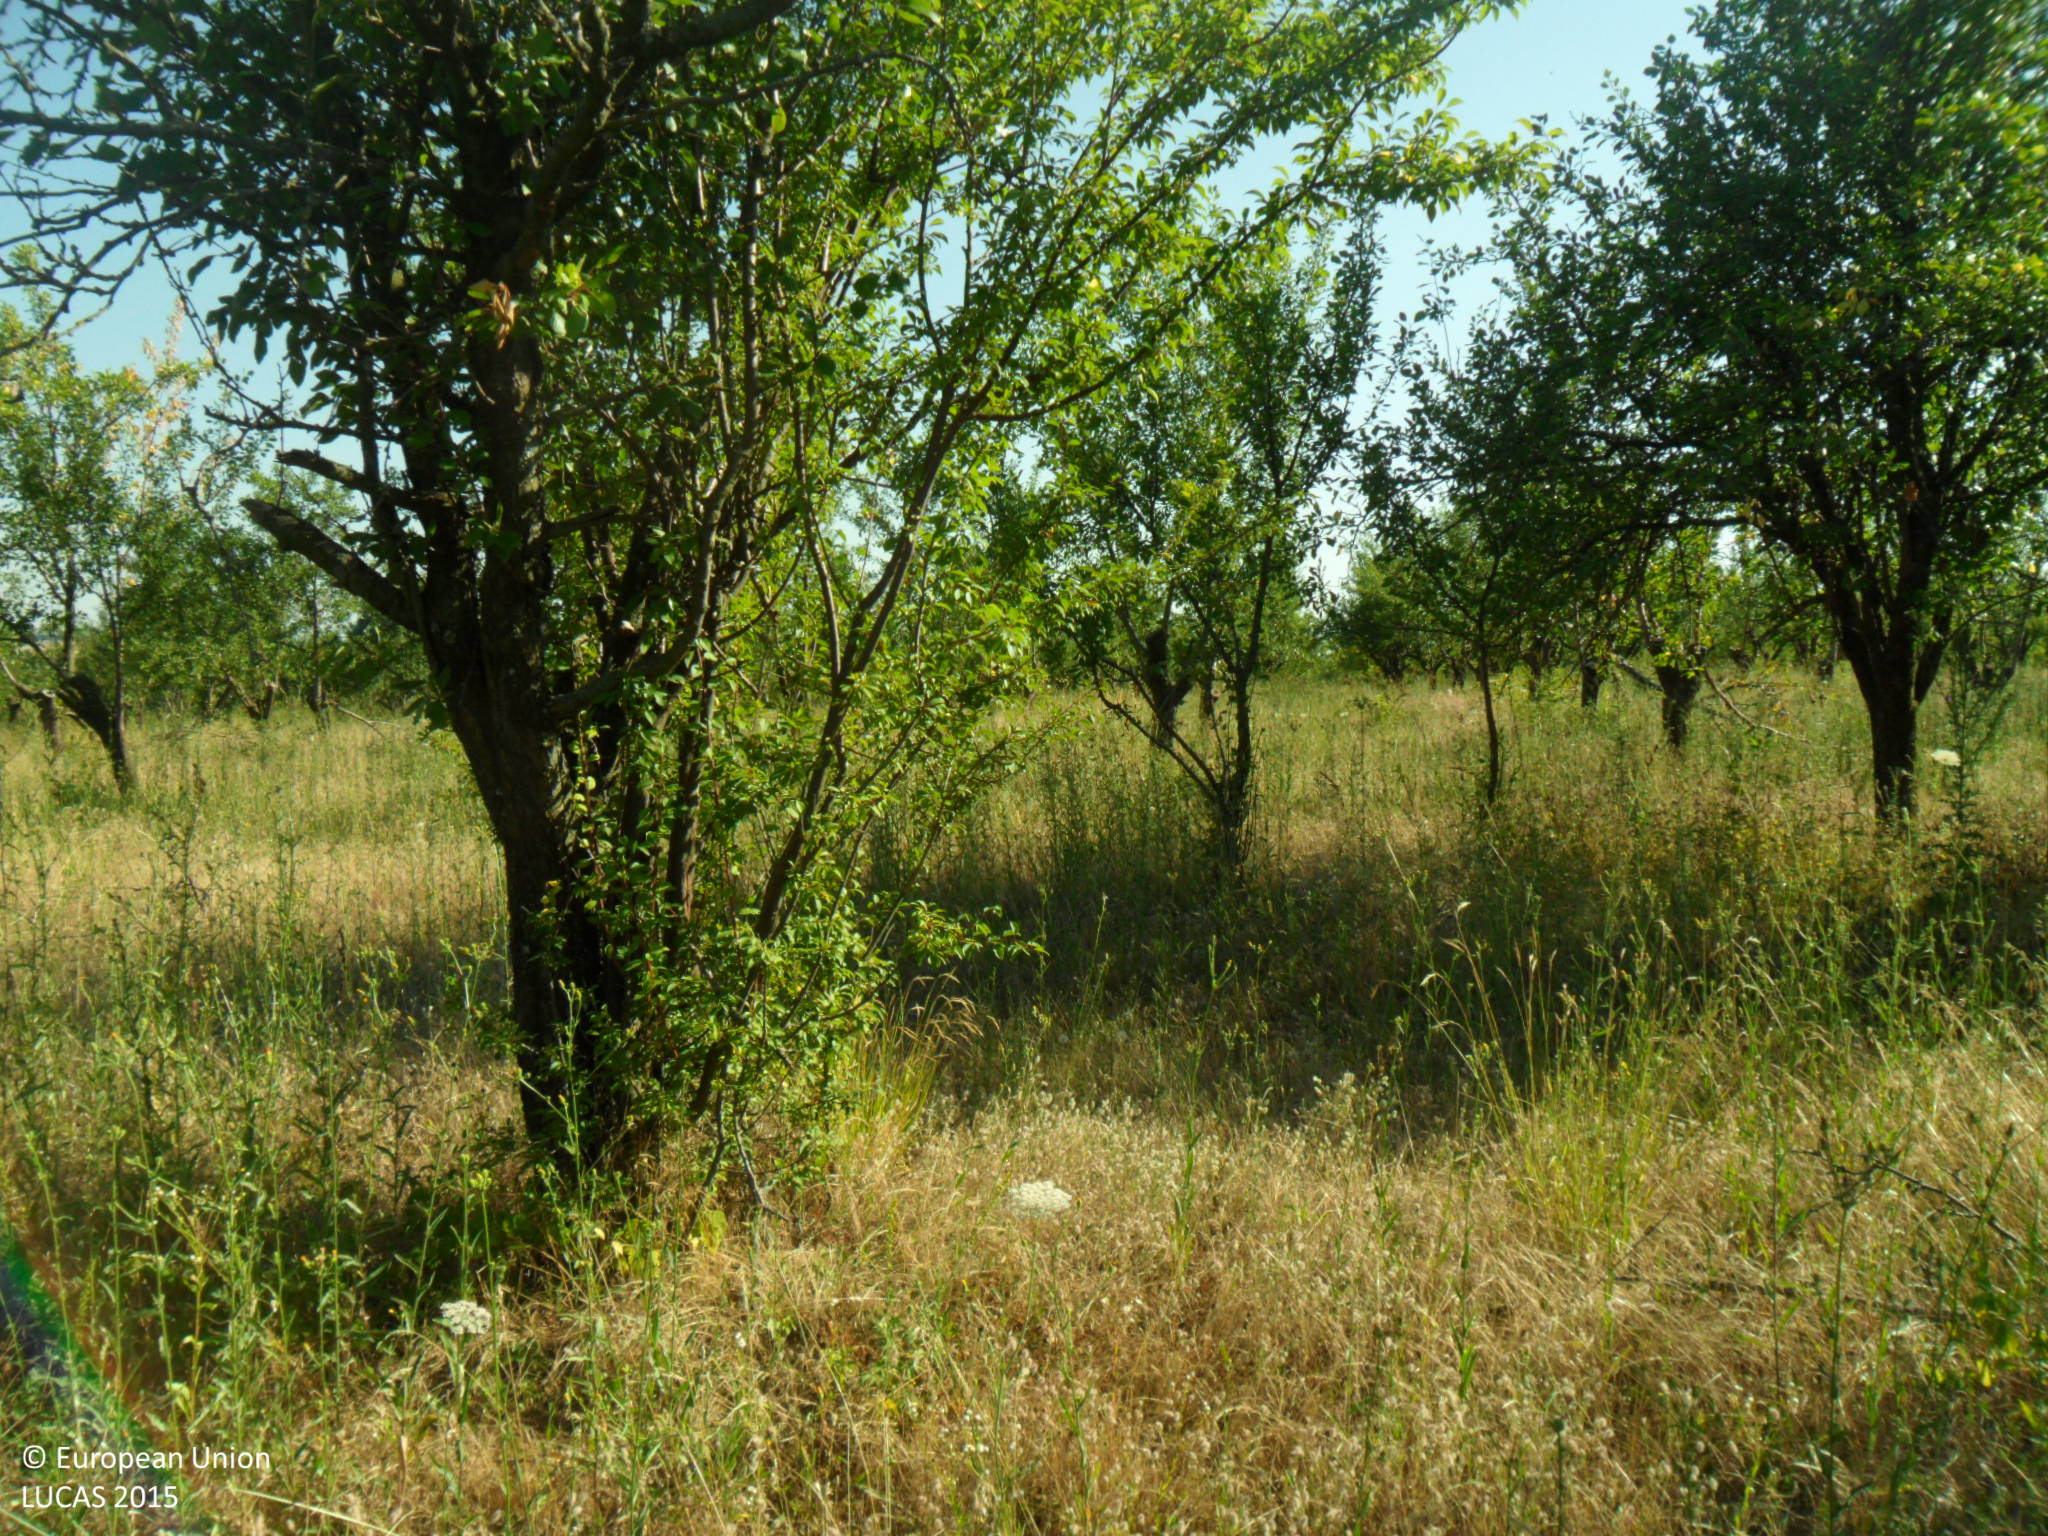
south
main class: Cropland
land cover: Other fruit trees and berries
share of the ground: 50 - 75 %
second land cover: Grassland without tree/shrub cover
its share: > 75 %
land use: Agriculture (excluding fallow land and kitchen gardens)
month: July
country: BG
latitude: 43.8274
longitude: 26.6123
